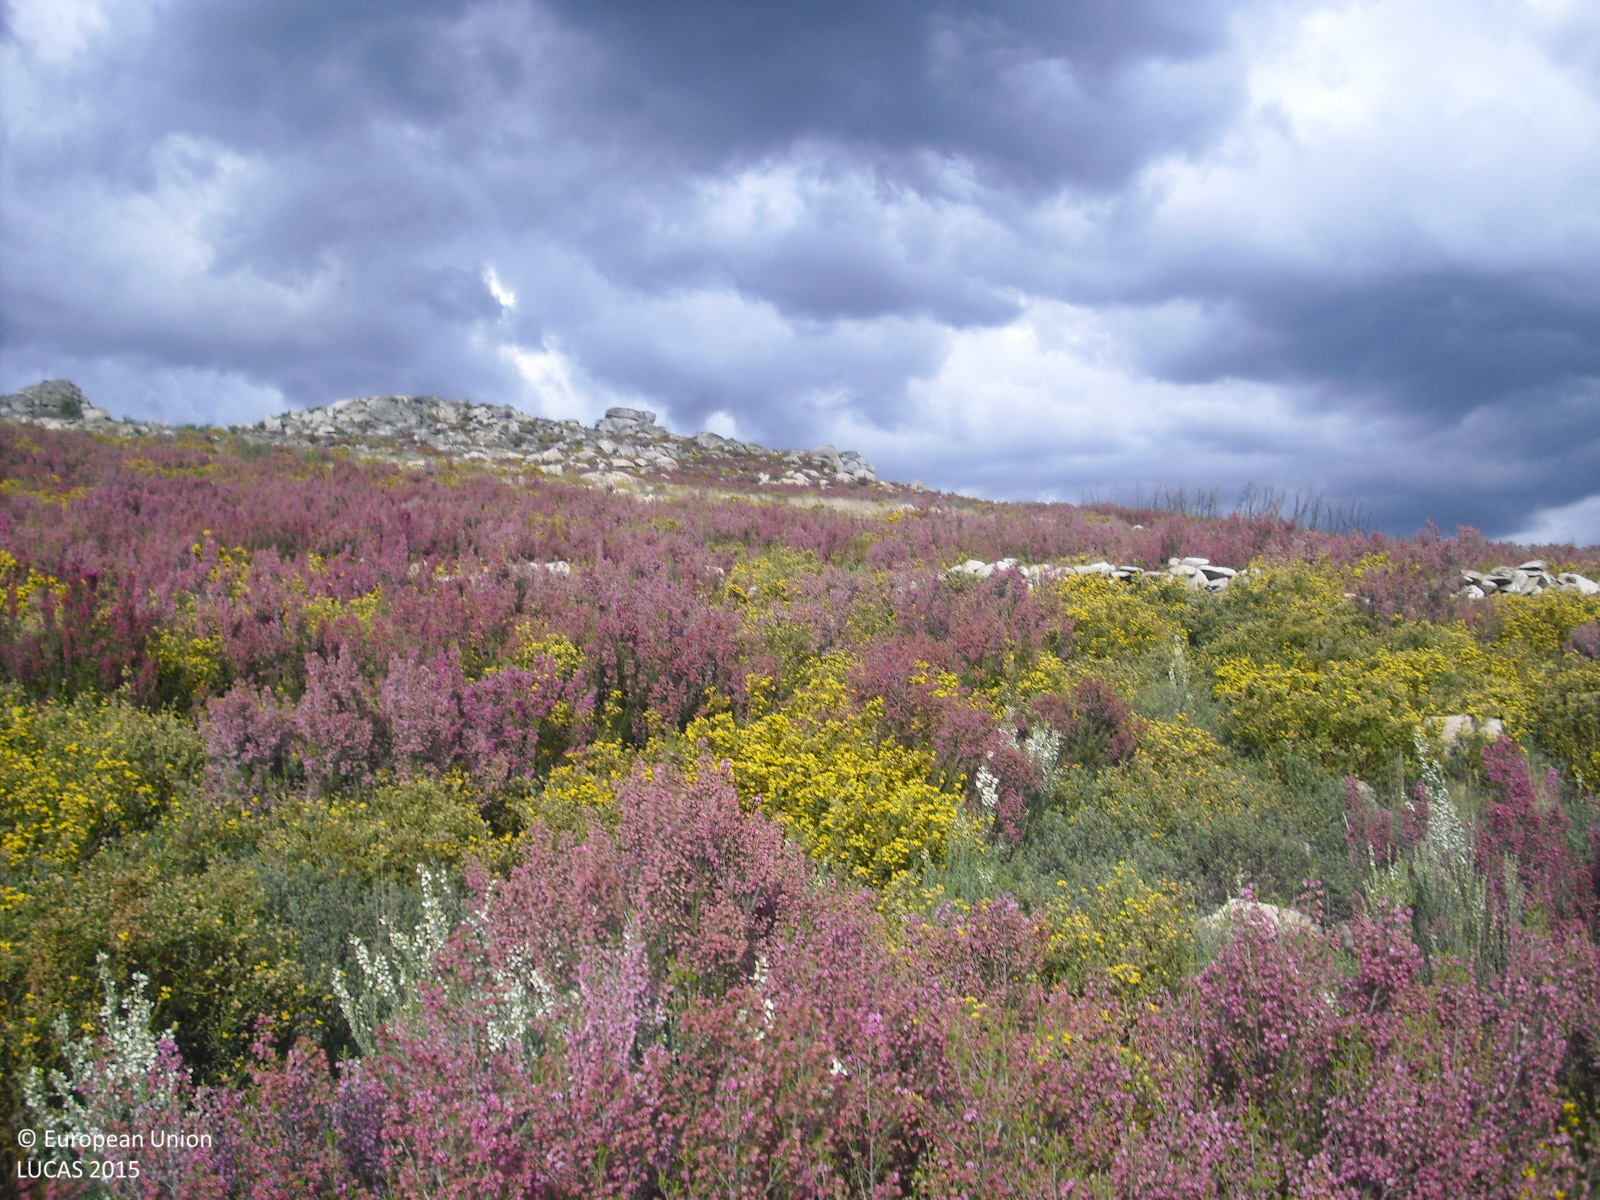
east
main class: Shrubland
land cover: Shrubland without tree cover
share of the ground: > 75 %
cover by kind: shrubs 70 %, consolidated bare surface 20 %, herbaceous plants 10 %
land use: Semi-natural and natural areas not in use
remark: Burnt area
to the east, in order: Shrubland without tree cover; Dry stone walls; Shrubland without tree cover; Rocks and stones; Shrubland with sparse tree cover; Rocks and stones; Shrubland without tree cover; Rocks and stones; Shrubland without tree cover
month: April
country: ES
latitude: 41.9363
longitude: -7.7618
